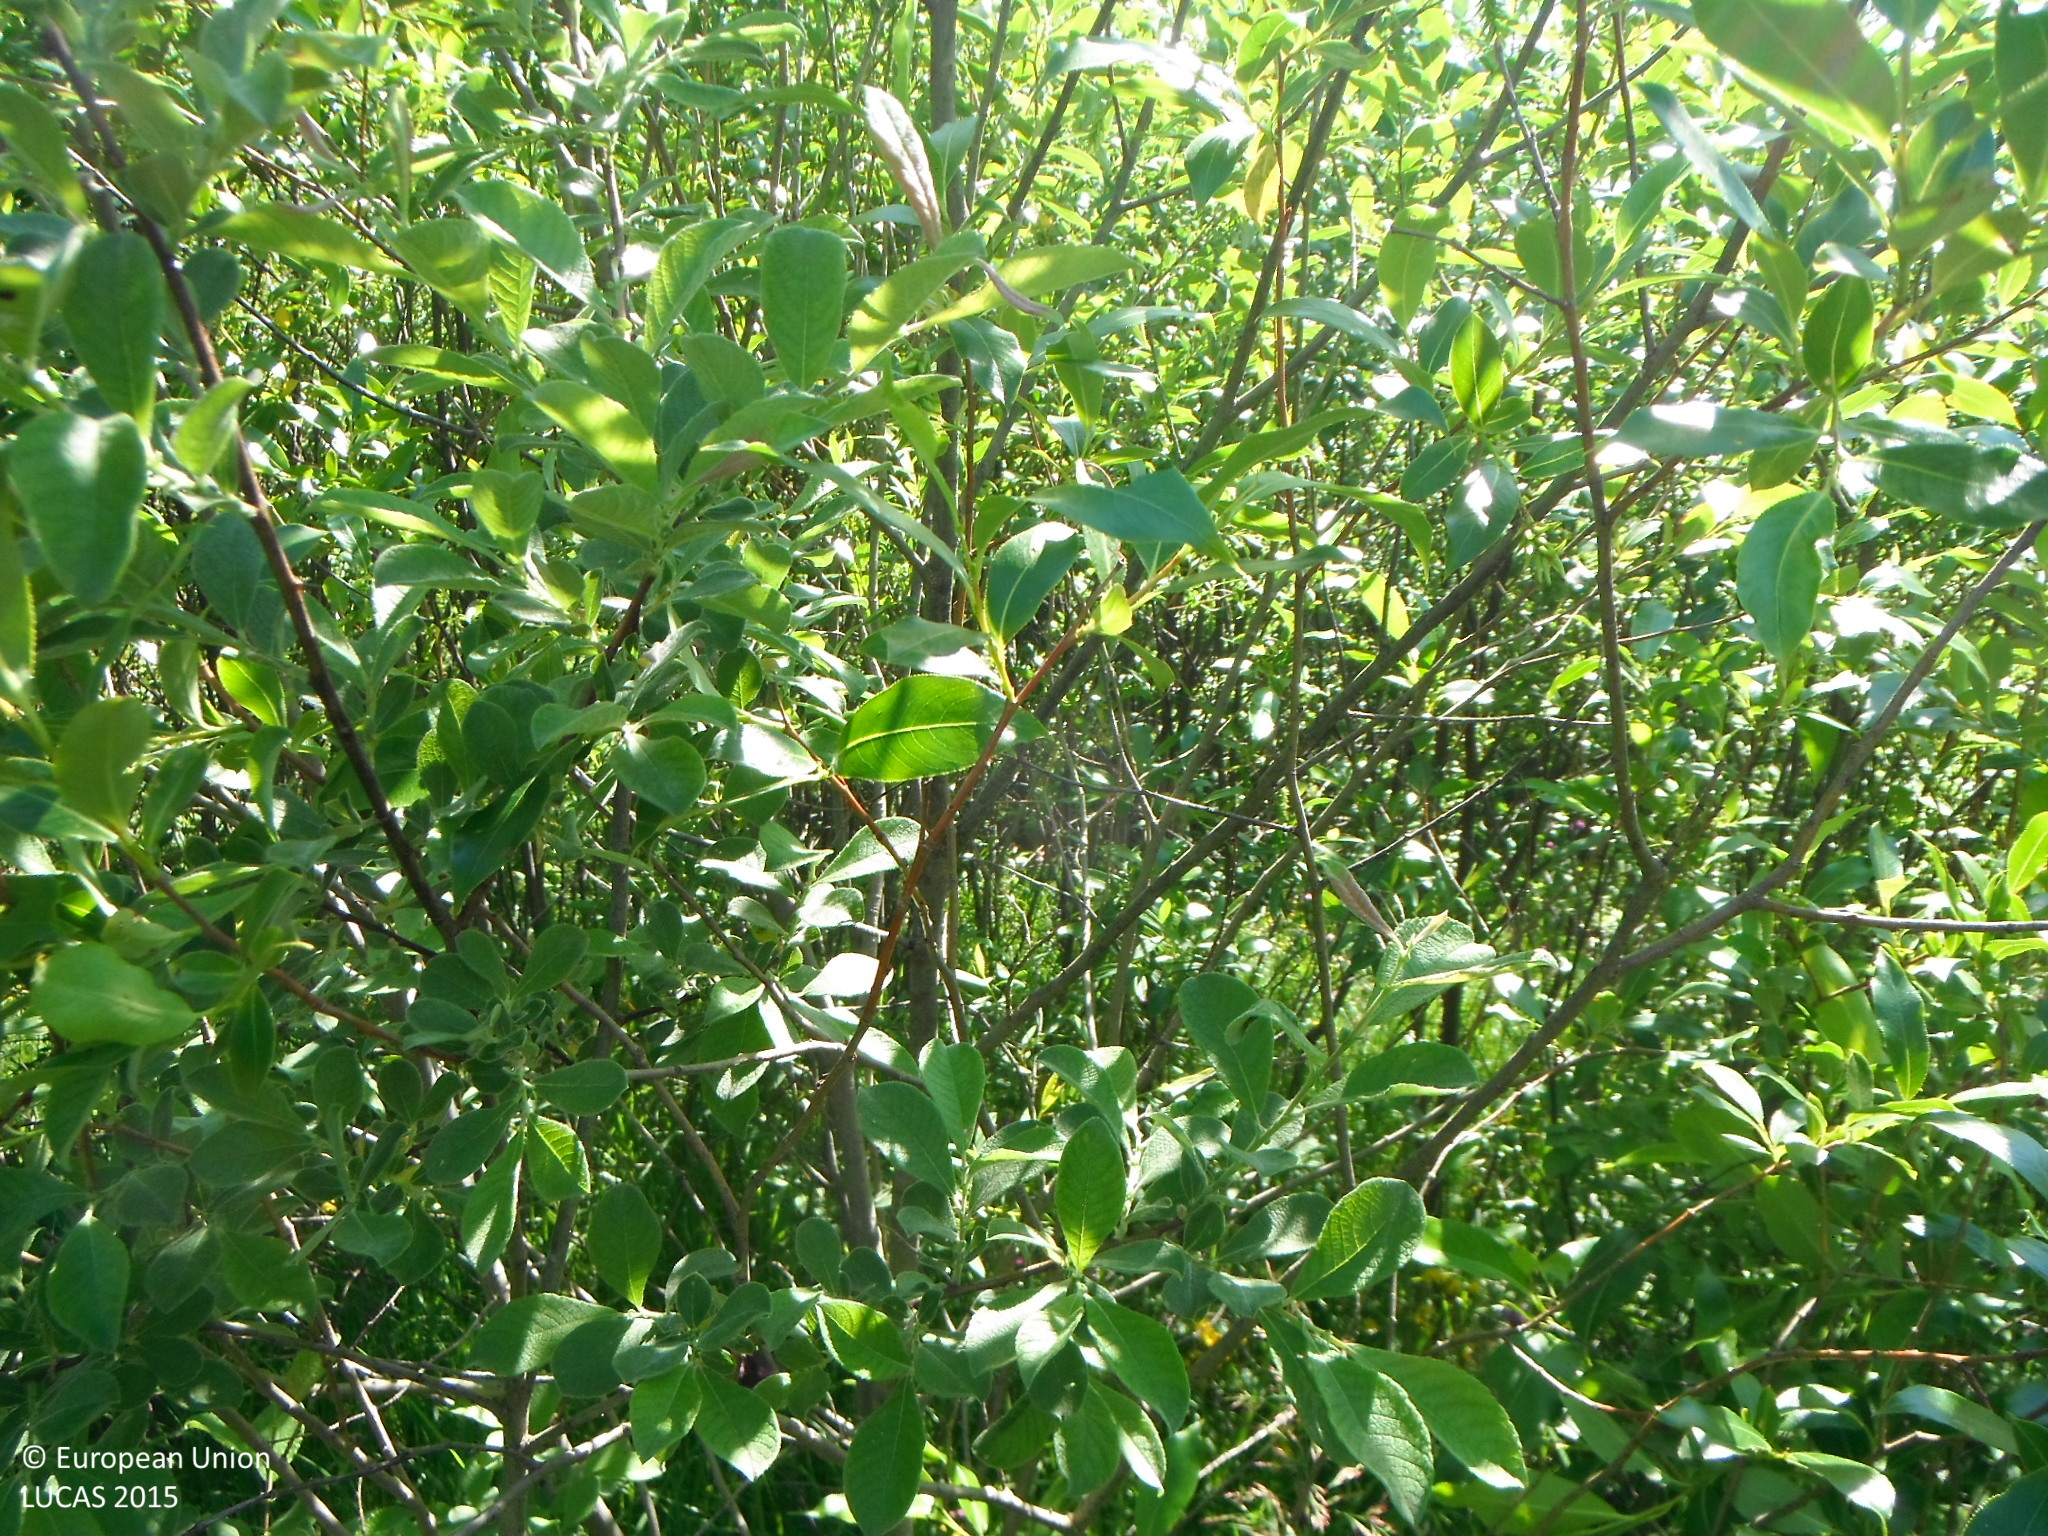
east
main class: Shrubland
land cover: Shrubland without tree cover
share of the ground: > 75 %
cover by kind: shrubs 80 %, herbaceous plants 20 %
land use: Semi-natural and natural areas not in use
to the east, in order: Shrubland without tree cover; Spontaneously vegetated surfaces; Grassland without tree/shrub cover; Paved roads, cycling and walking lanes; Grass margins; Ditches and canals; Grassland without tree/shrub cover; Shrubland with sparse tree cover; Grassland without tree/shrub cover; Tracks; Grassland without tree/shrub cover
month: July
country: SK
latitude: 49.4207
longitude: 19.3303
